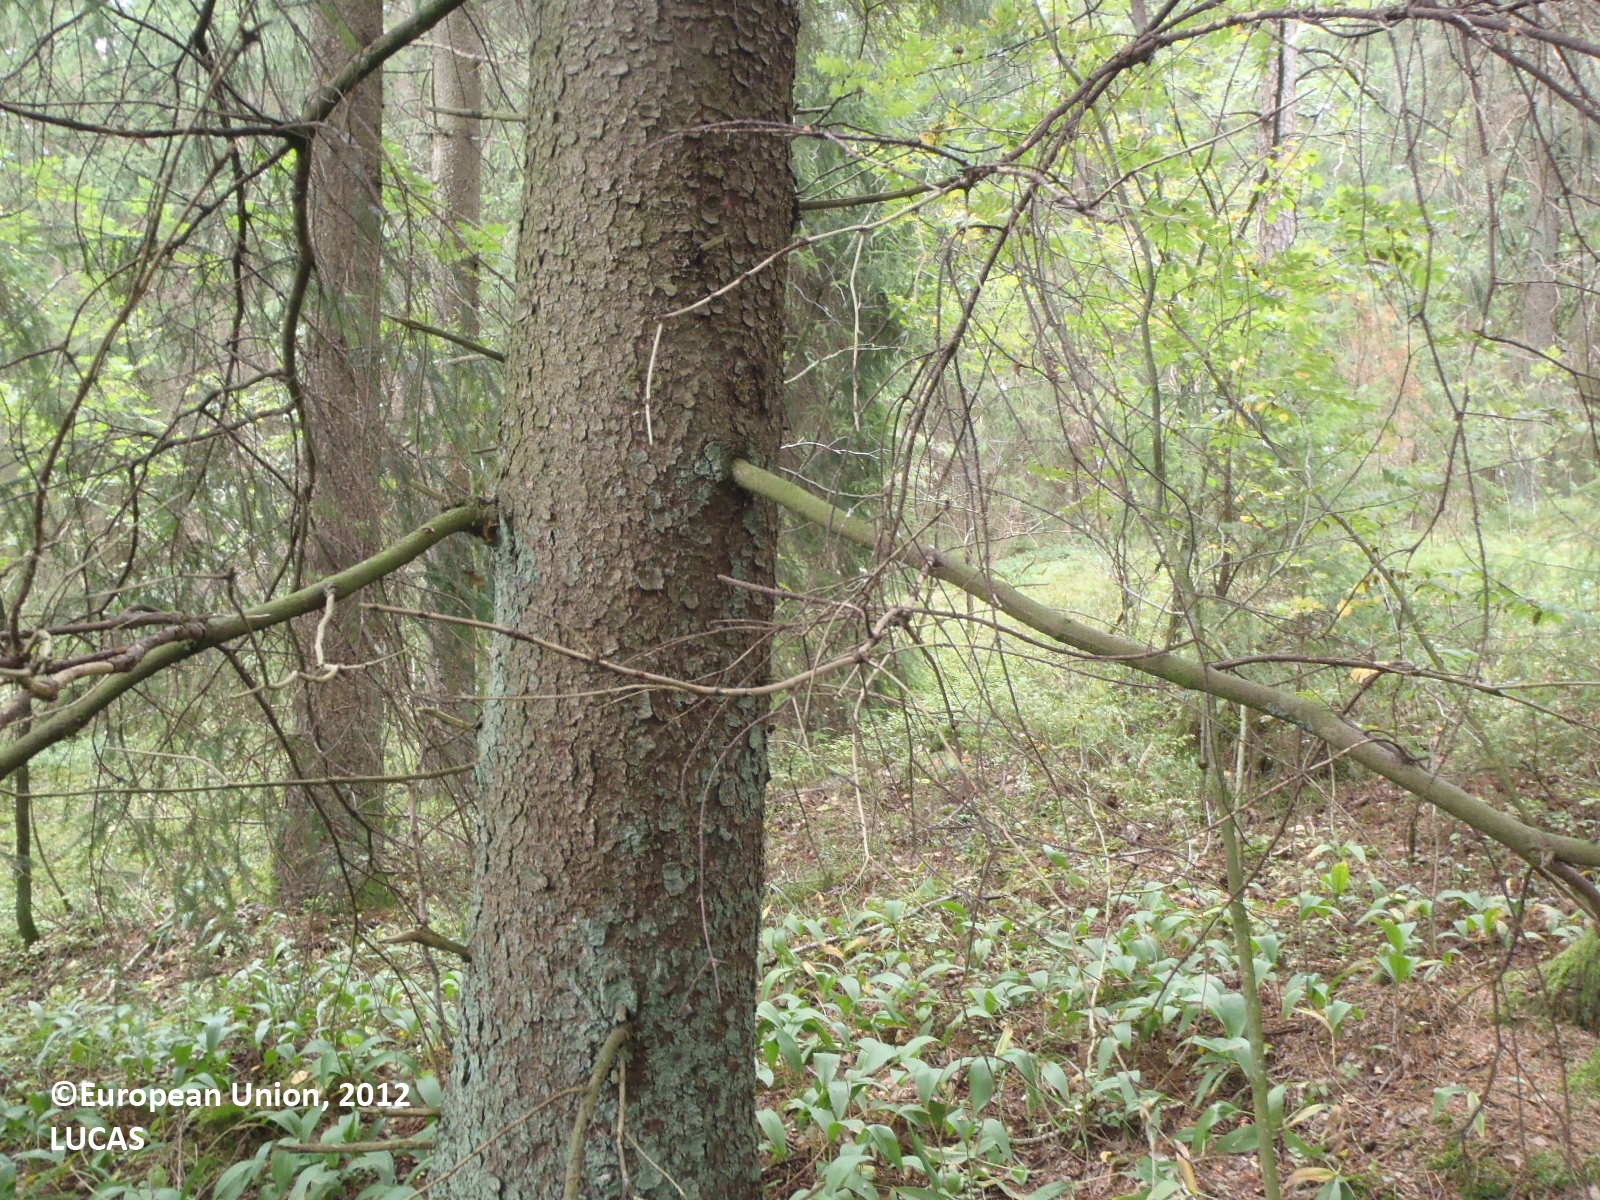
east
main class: Woodland
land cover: Spruce dominated coniferous woodland
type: boreal forest
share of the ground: > 75 %
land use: Forestry
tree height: > 5 m
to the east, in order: Spruce dominated coniferous woodland; Temporary grasslands; Broadleaved woodland; Inland running water
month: August
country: FI
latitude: 60.7161
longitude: 21.8815
